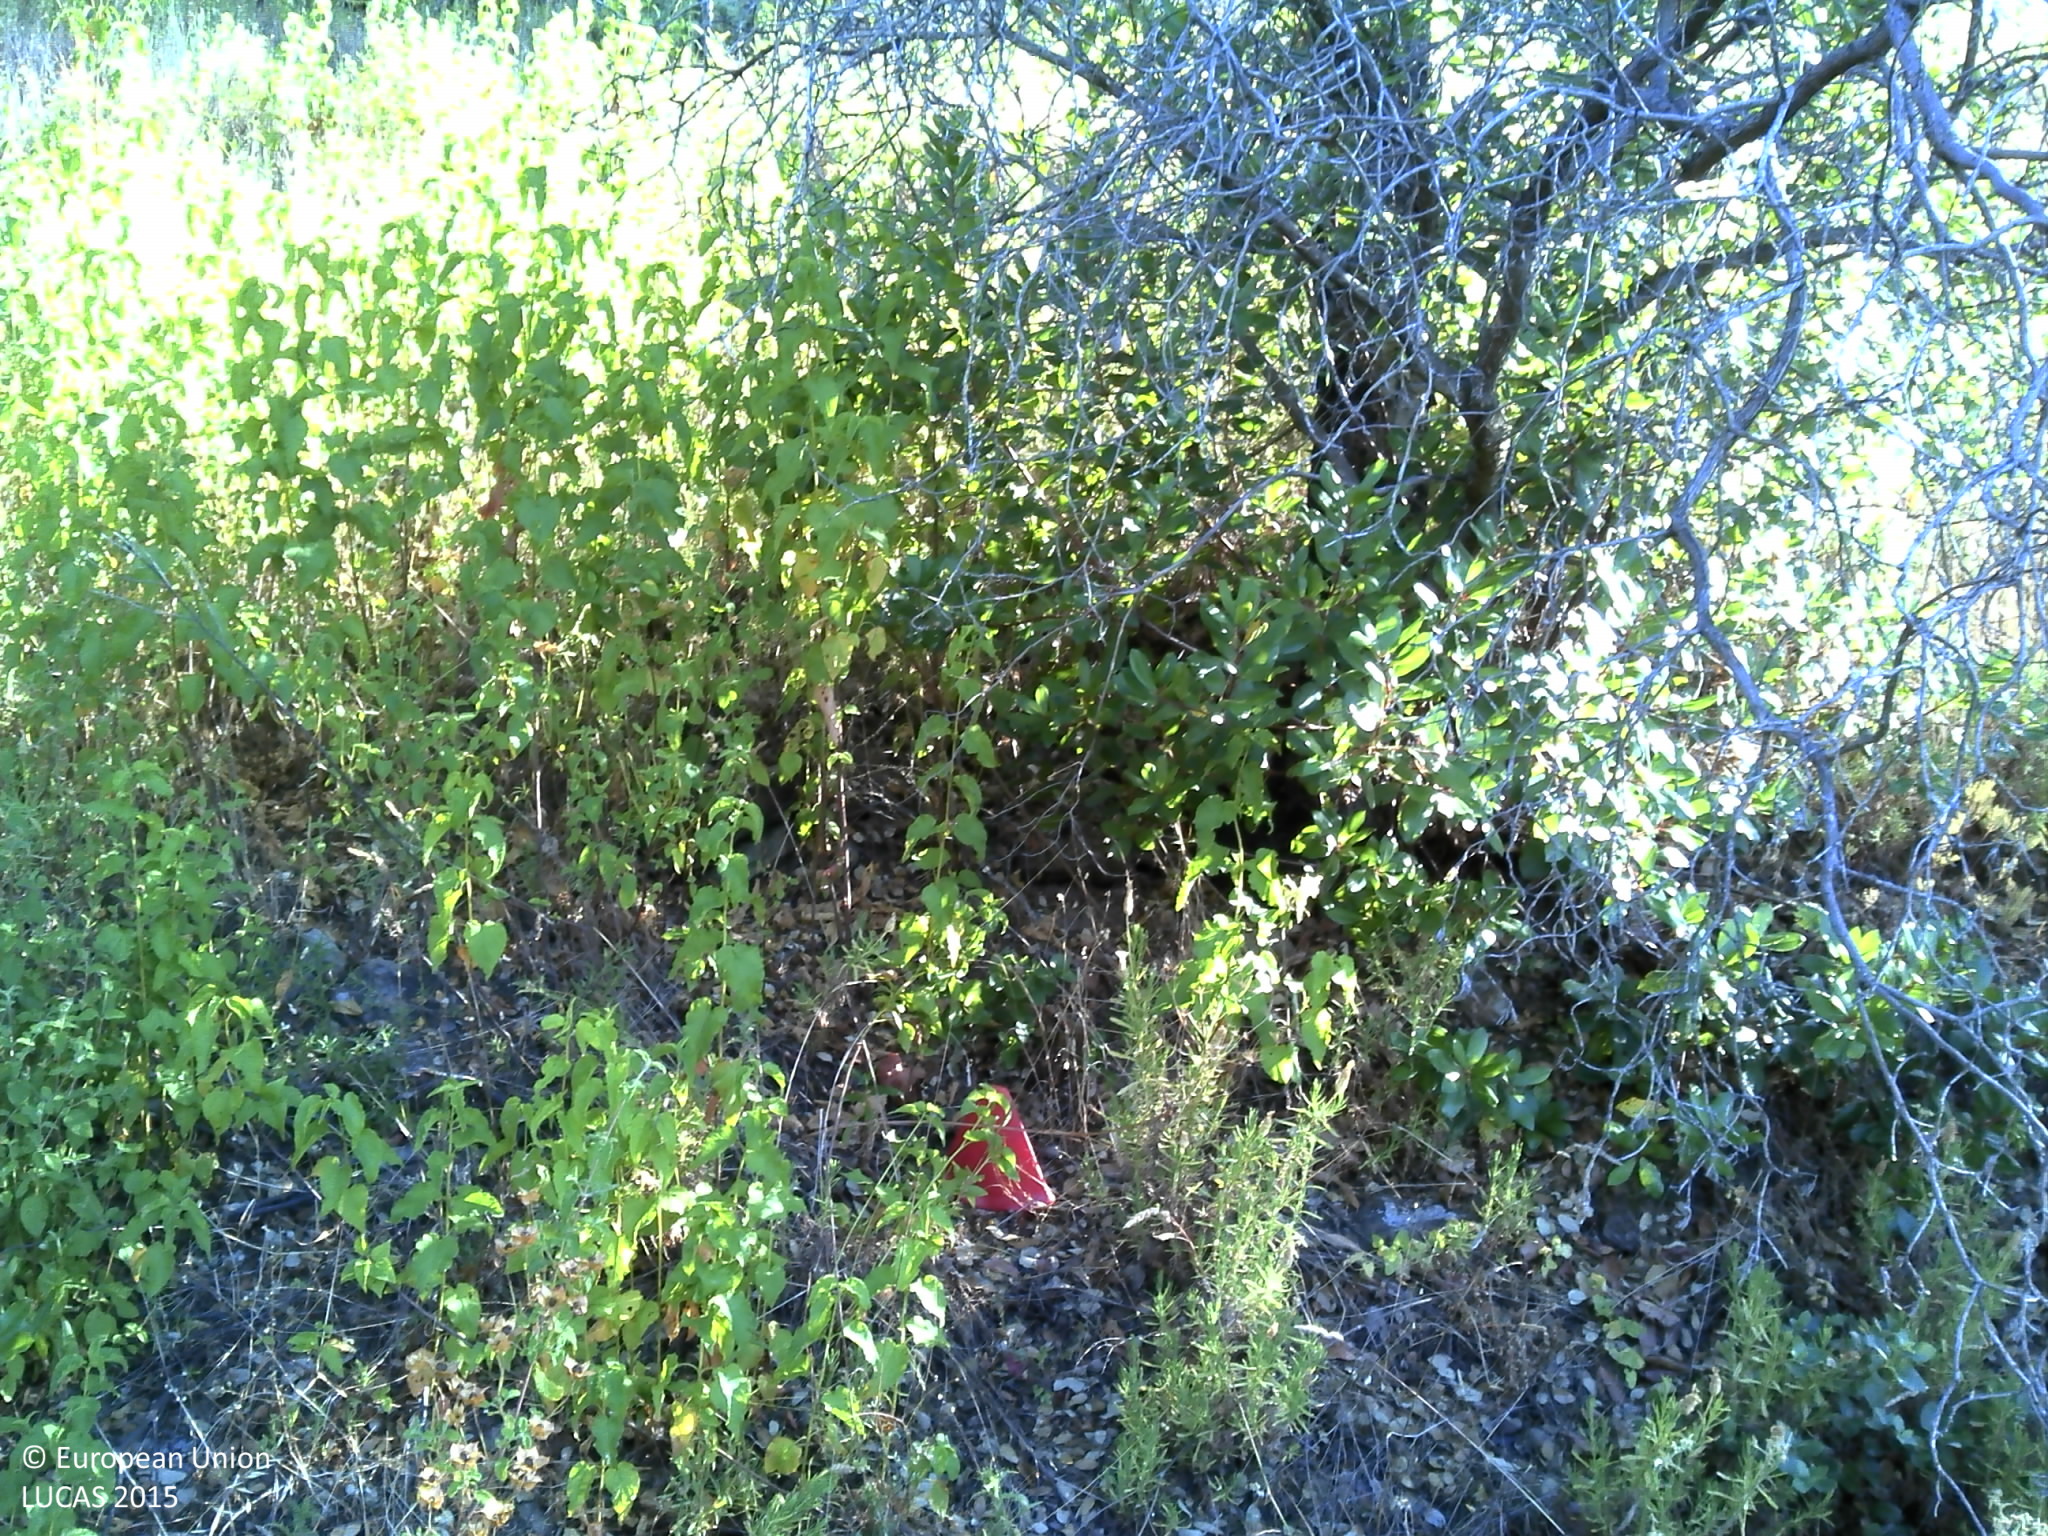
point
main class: Woodland
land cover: Broadleaved woodland
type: broadleaved evergreen forest
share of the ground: 25 - 50 %
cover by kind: broadleaved forest trees 45 %, shrubs 30 %, unconsolidated bare surface 20 %, herbaceous plants 5 %
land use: Forestry
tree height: > 5 m
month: June
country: PT
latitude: 37.2456
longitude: -7.8576
